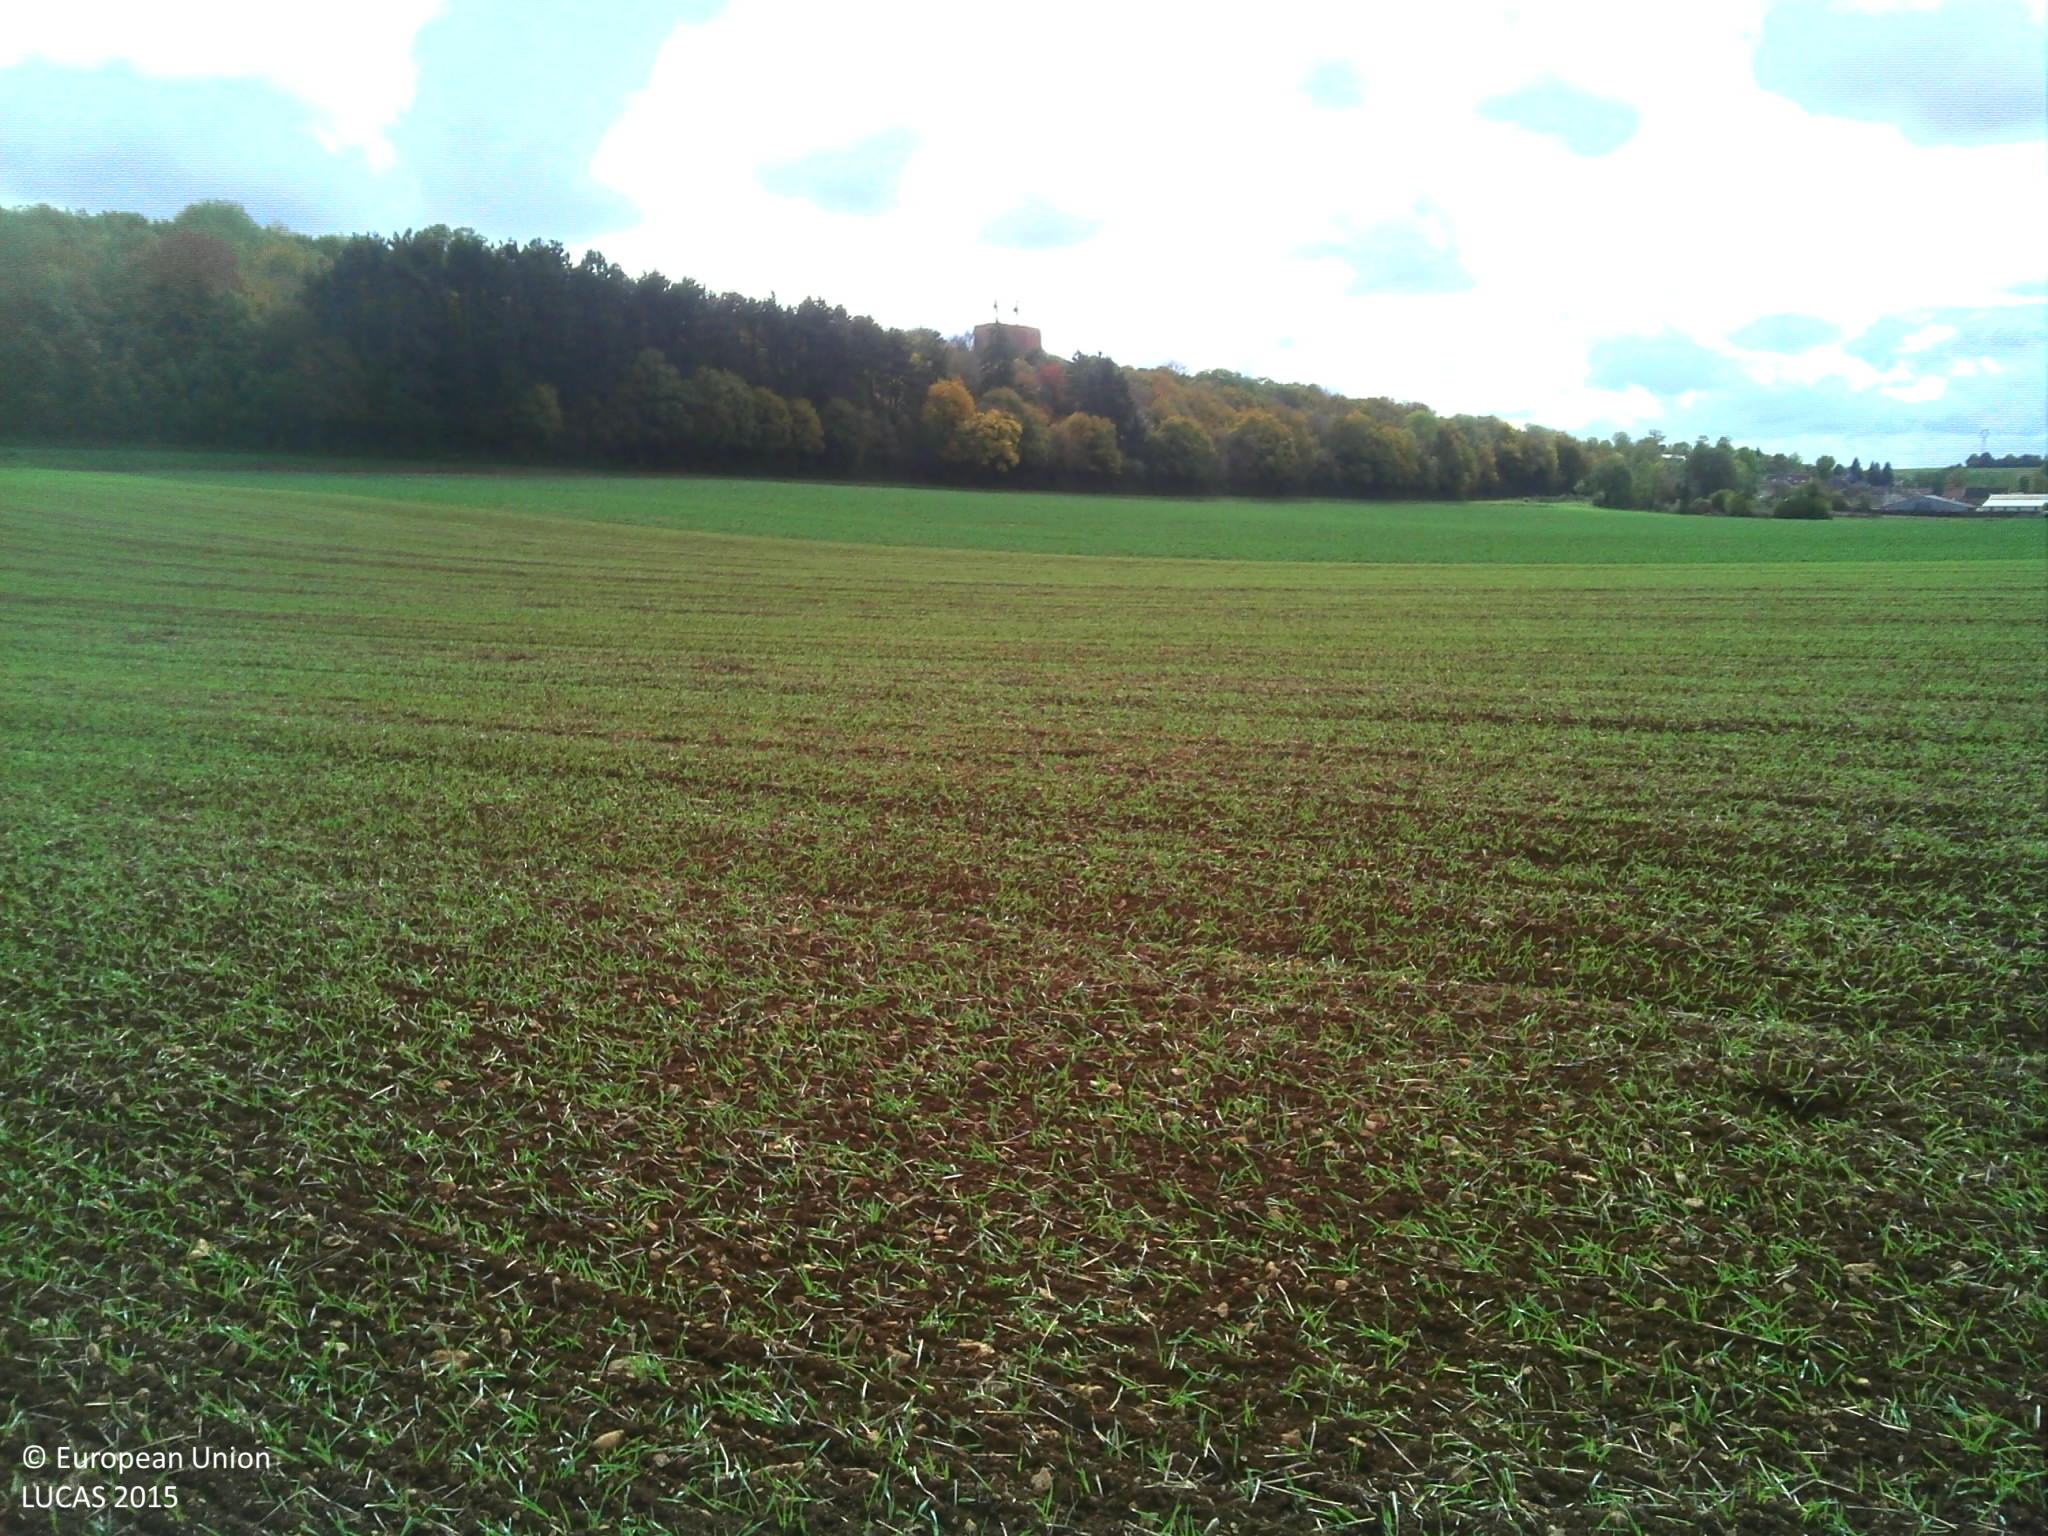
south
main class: Cropland
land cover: Common wheat
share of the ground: 25 - 50 %
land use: Agriculture (excluding fallow land and kitchen gardens)
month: October
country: FR
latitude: 47.3842
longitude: 4.9003
